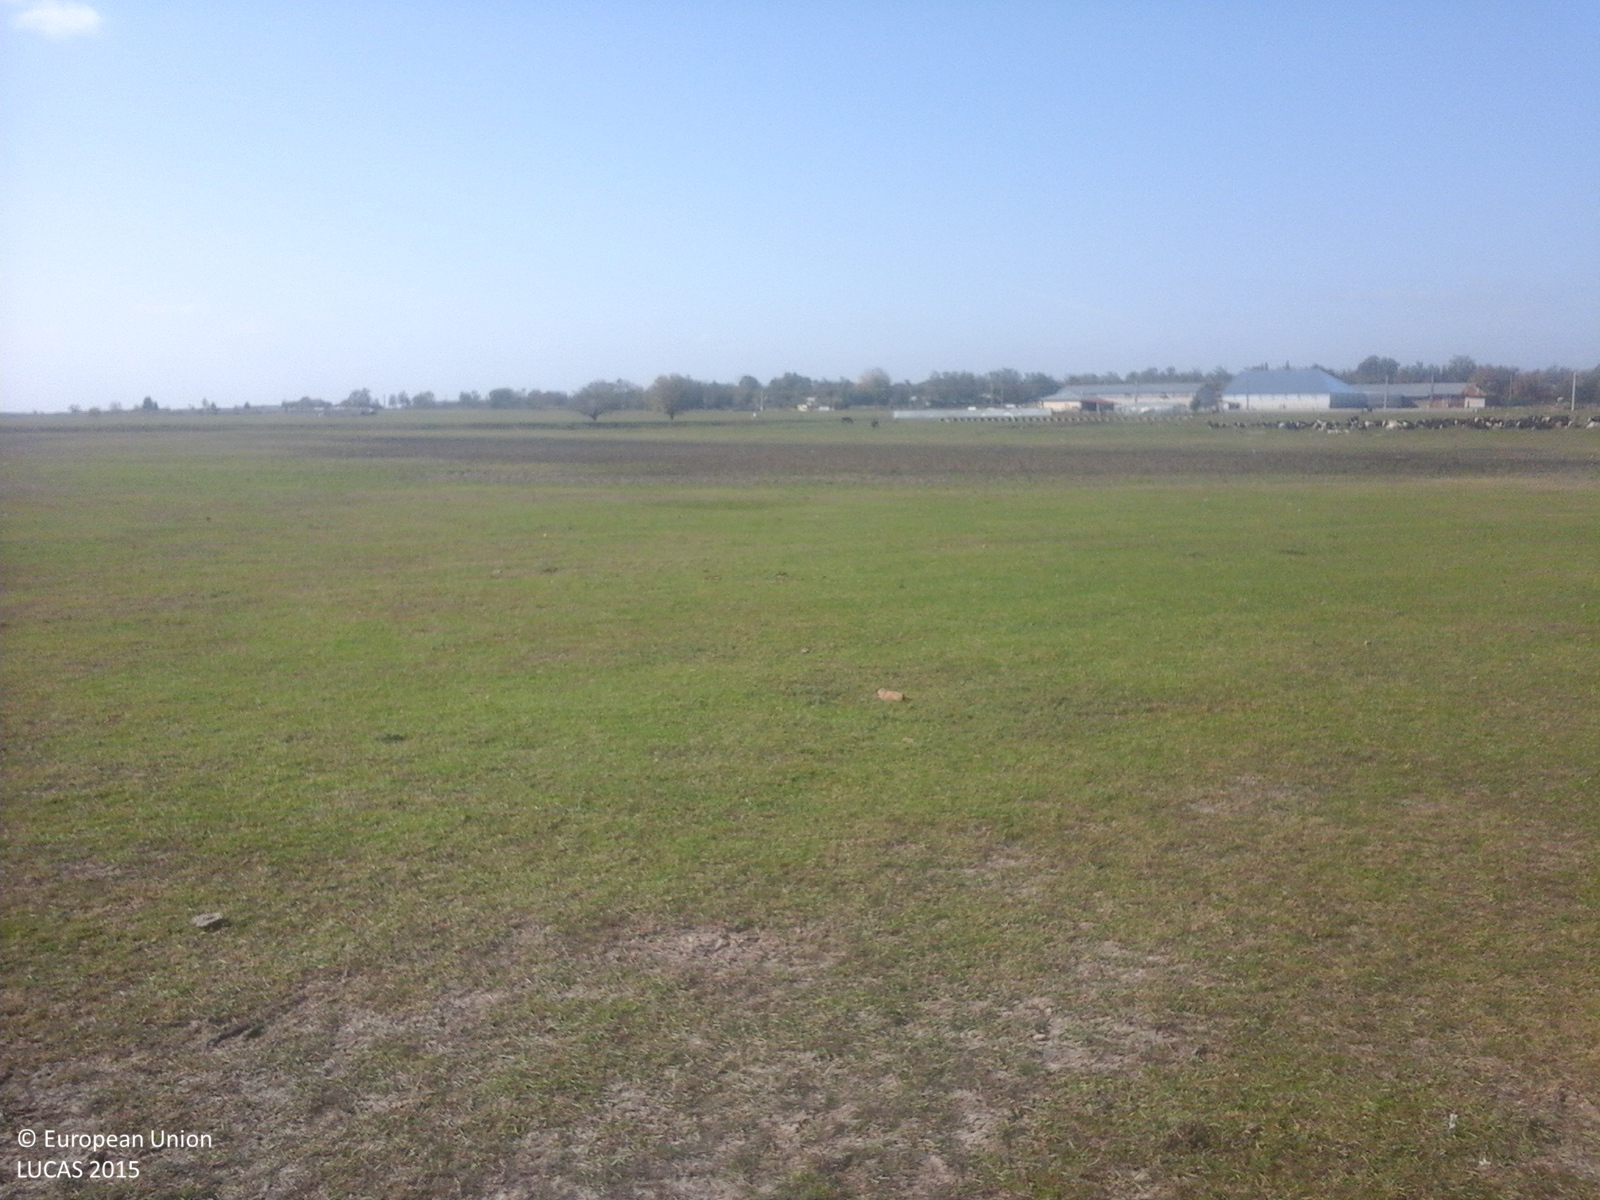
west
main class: Grassland
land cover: Grassland without tree/shrub cover
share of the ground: > 75 %
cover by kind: herbaceous plants 100 %
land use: Agriculture (excluding fallow land and kitchen gardens)
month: October
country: RO
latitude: 45.2839
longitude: 27.3714
